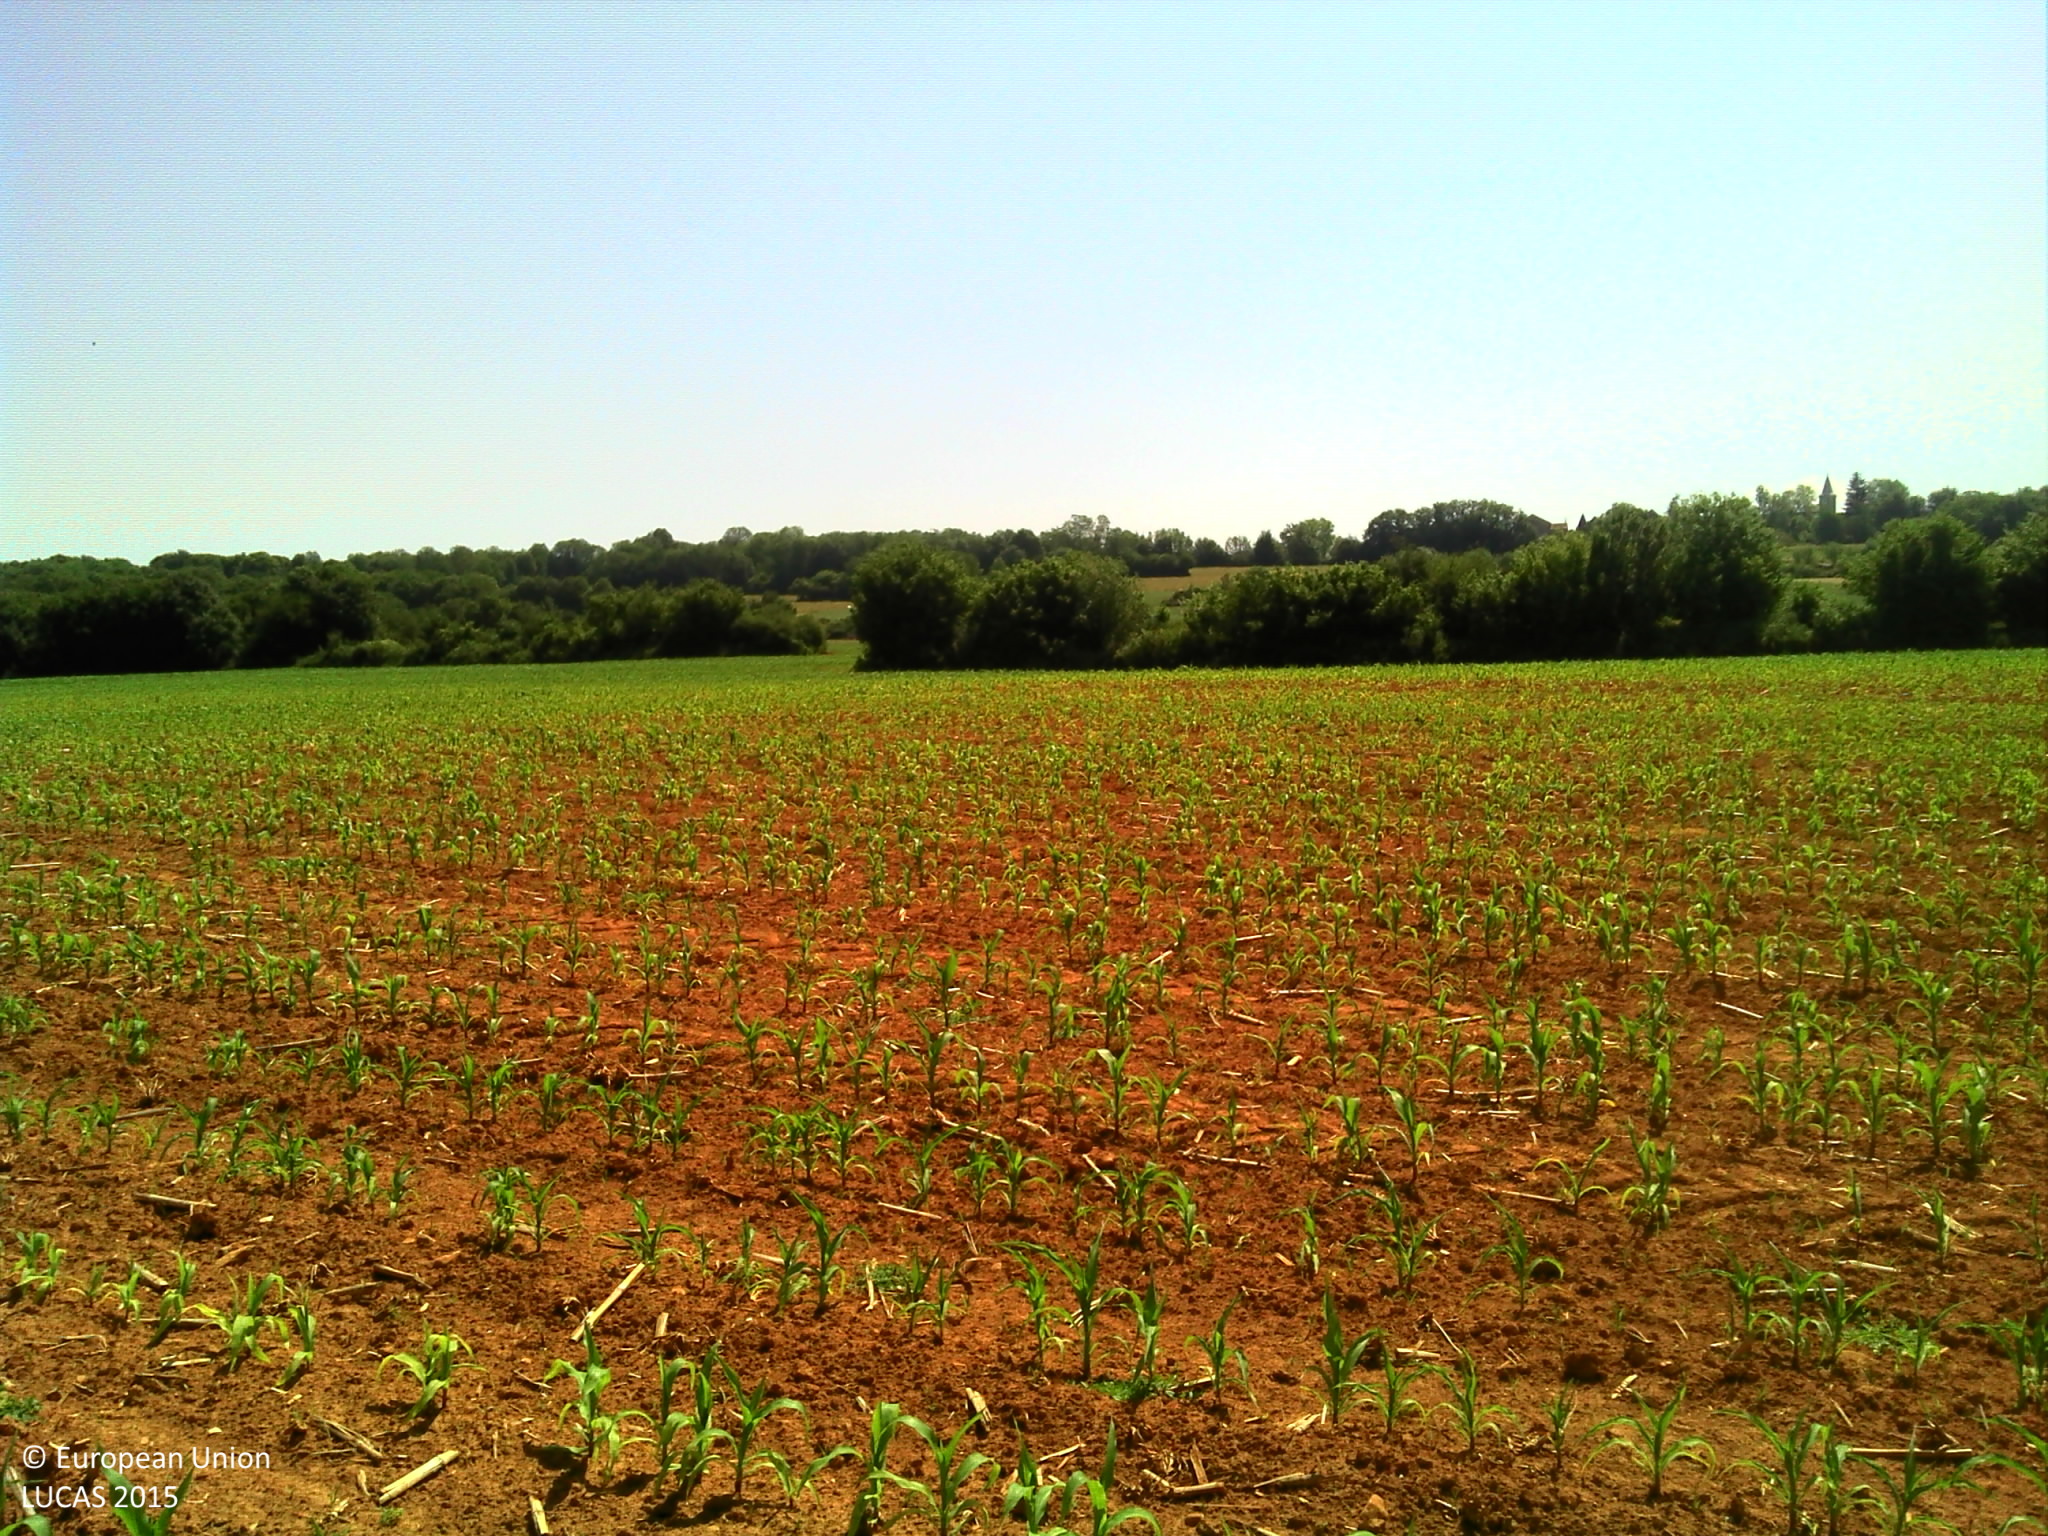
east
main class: Cropland
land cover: Rye
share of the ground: > 75 %
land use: Agriculture (excluding fallow land and kitchen gardens)
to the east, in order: Rye; Maize; Broadleaved woodland; Maize
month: June
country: FR
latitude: 47.5810
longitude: 6.1855
